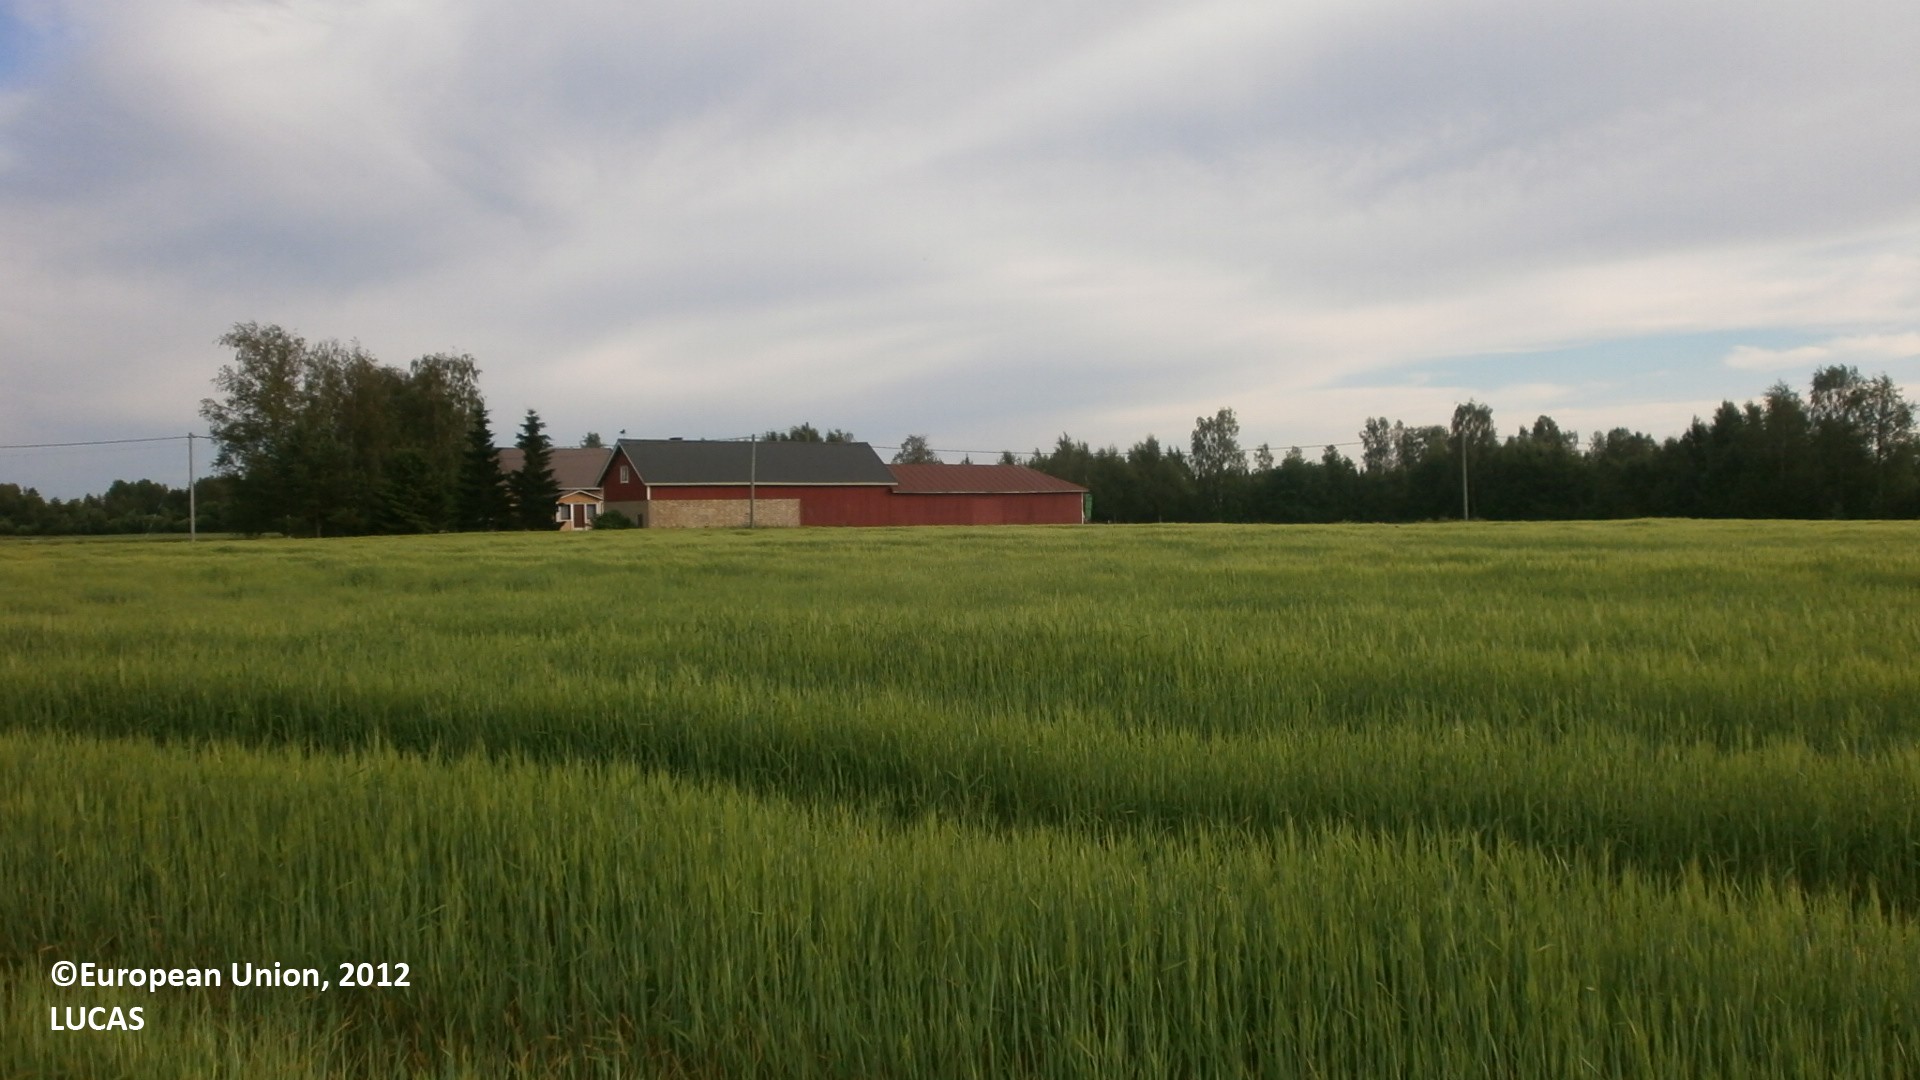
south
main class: Cropland
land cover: Barley
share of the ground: > 75 %
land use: Agriculture (excluding fallow land and kitchen gardens)
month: July
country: FI
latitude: 64.4073
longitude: 24.3209
